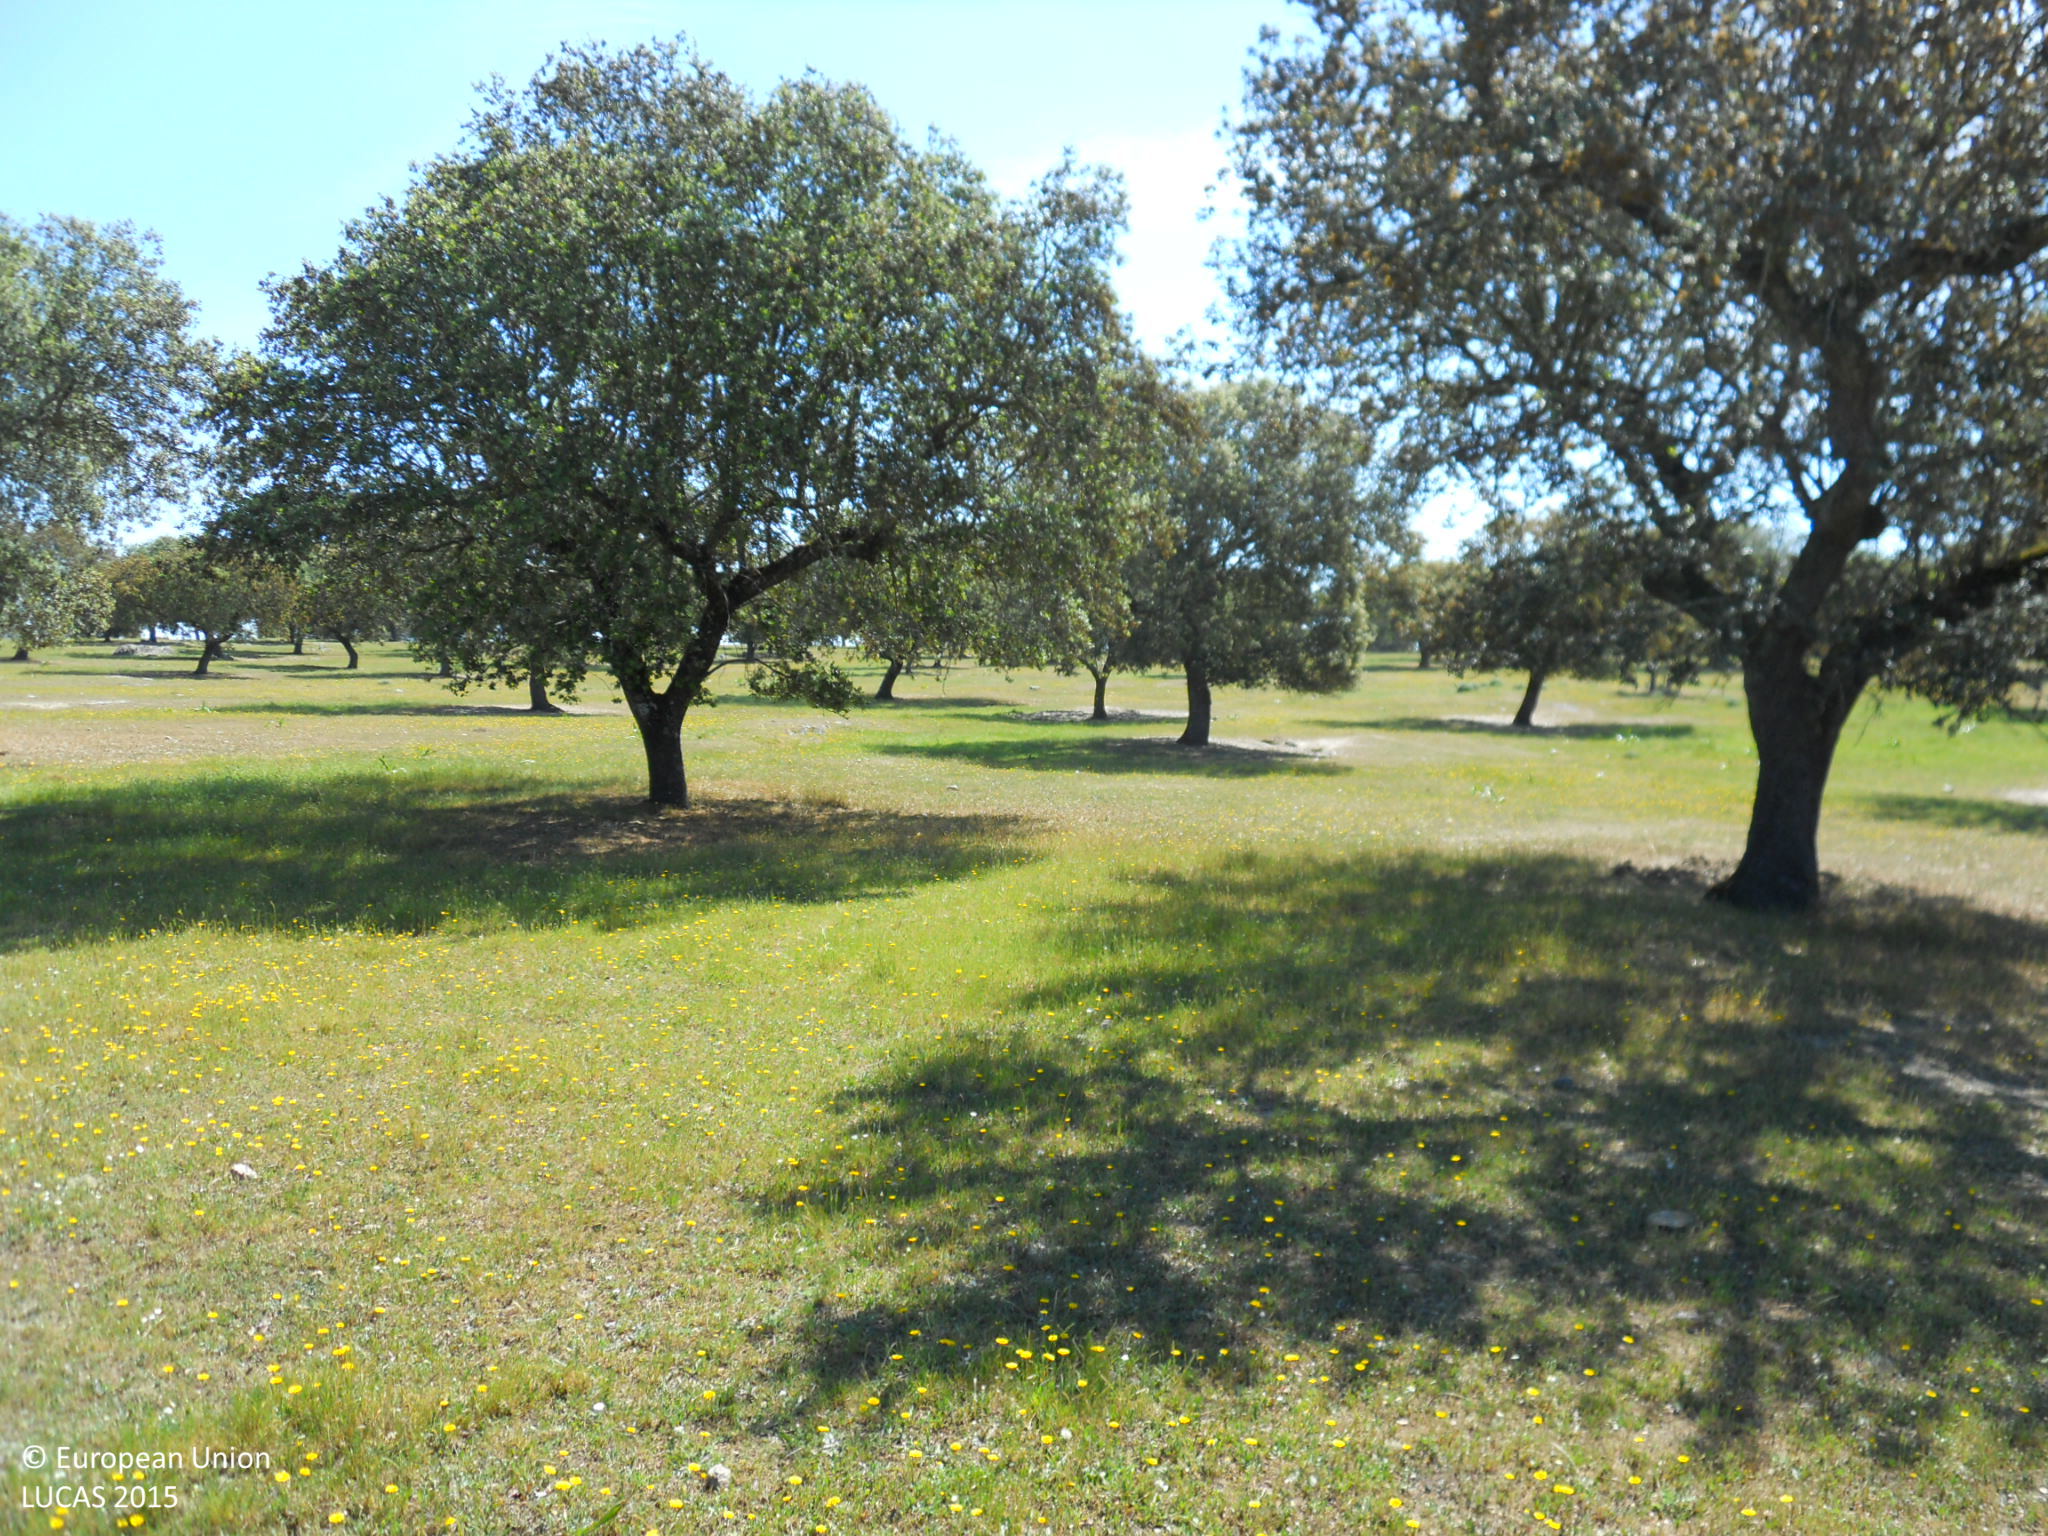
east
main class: Woodland
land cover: Broadleaved woodland
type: broadleaved evergreen forest
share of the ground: 25 - 50 %
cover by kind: herbaceous plants 65 %, broadleaved forest trees 35 %
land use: Forestry
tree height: > 5 m
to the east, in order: Broadleaved woodland; Tracks; Broadleaved woodland; Rock outcrops; Broadleaved woodland
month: April
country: ES
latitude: 39.3418
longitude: -7.0074
